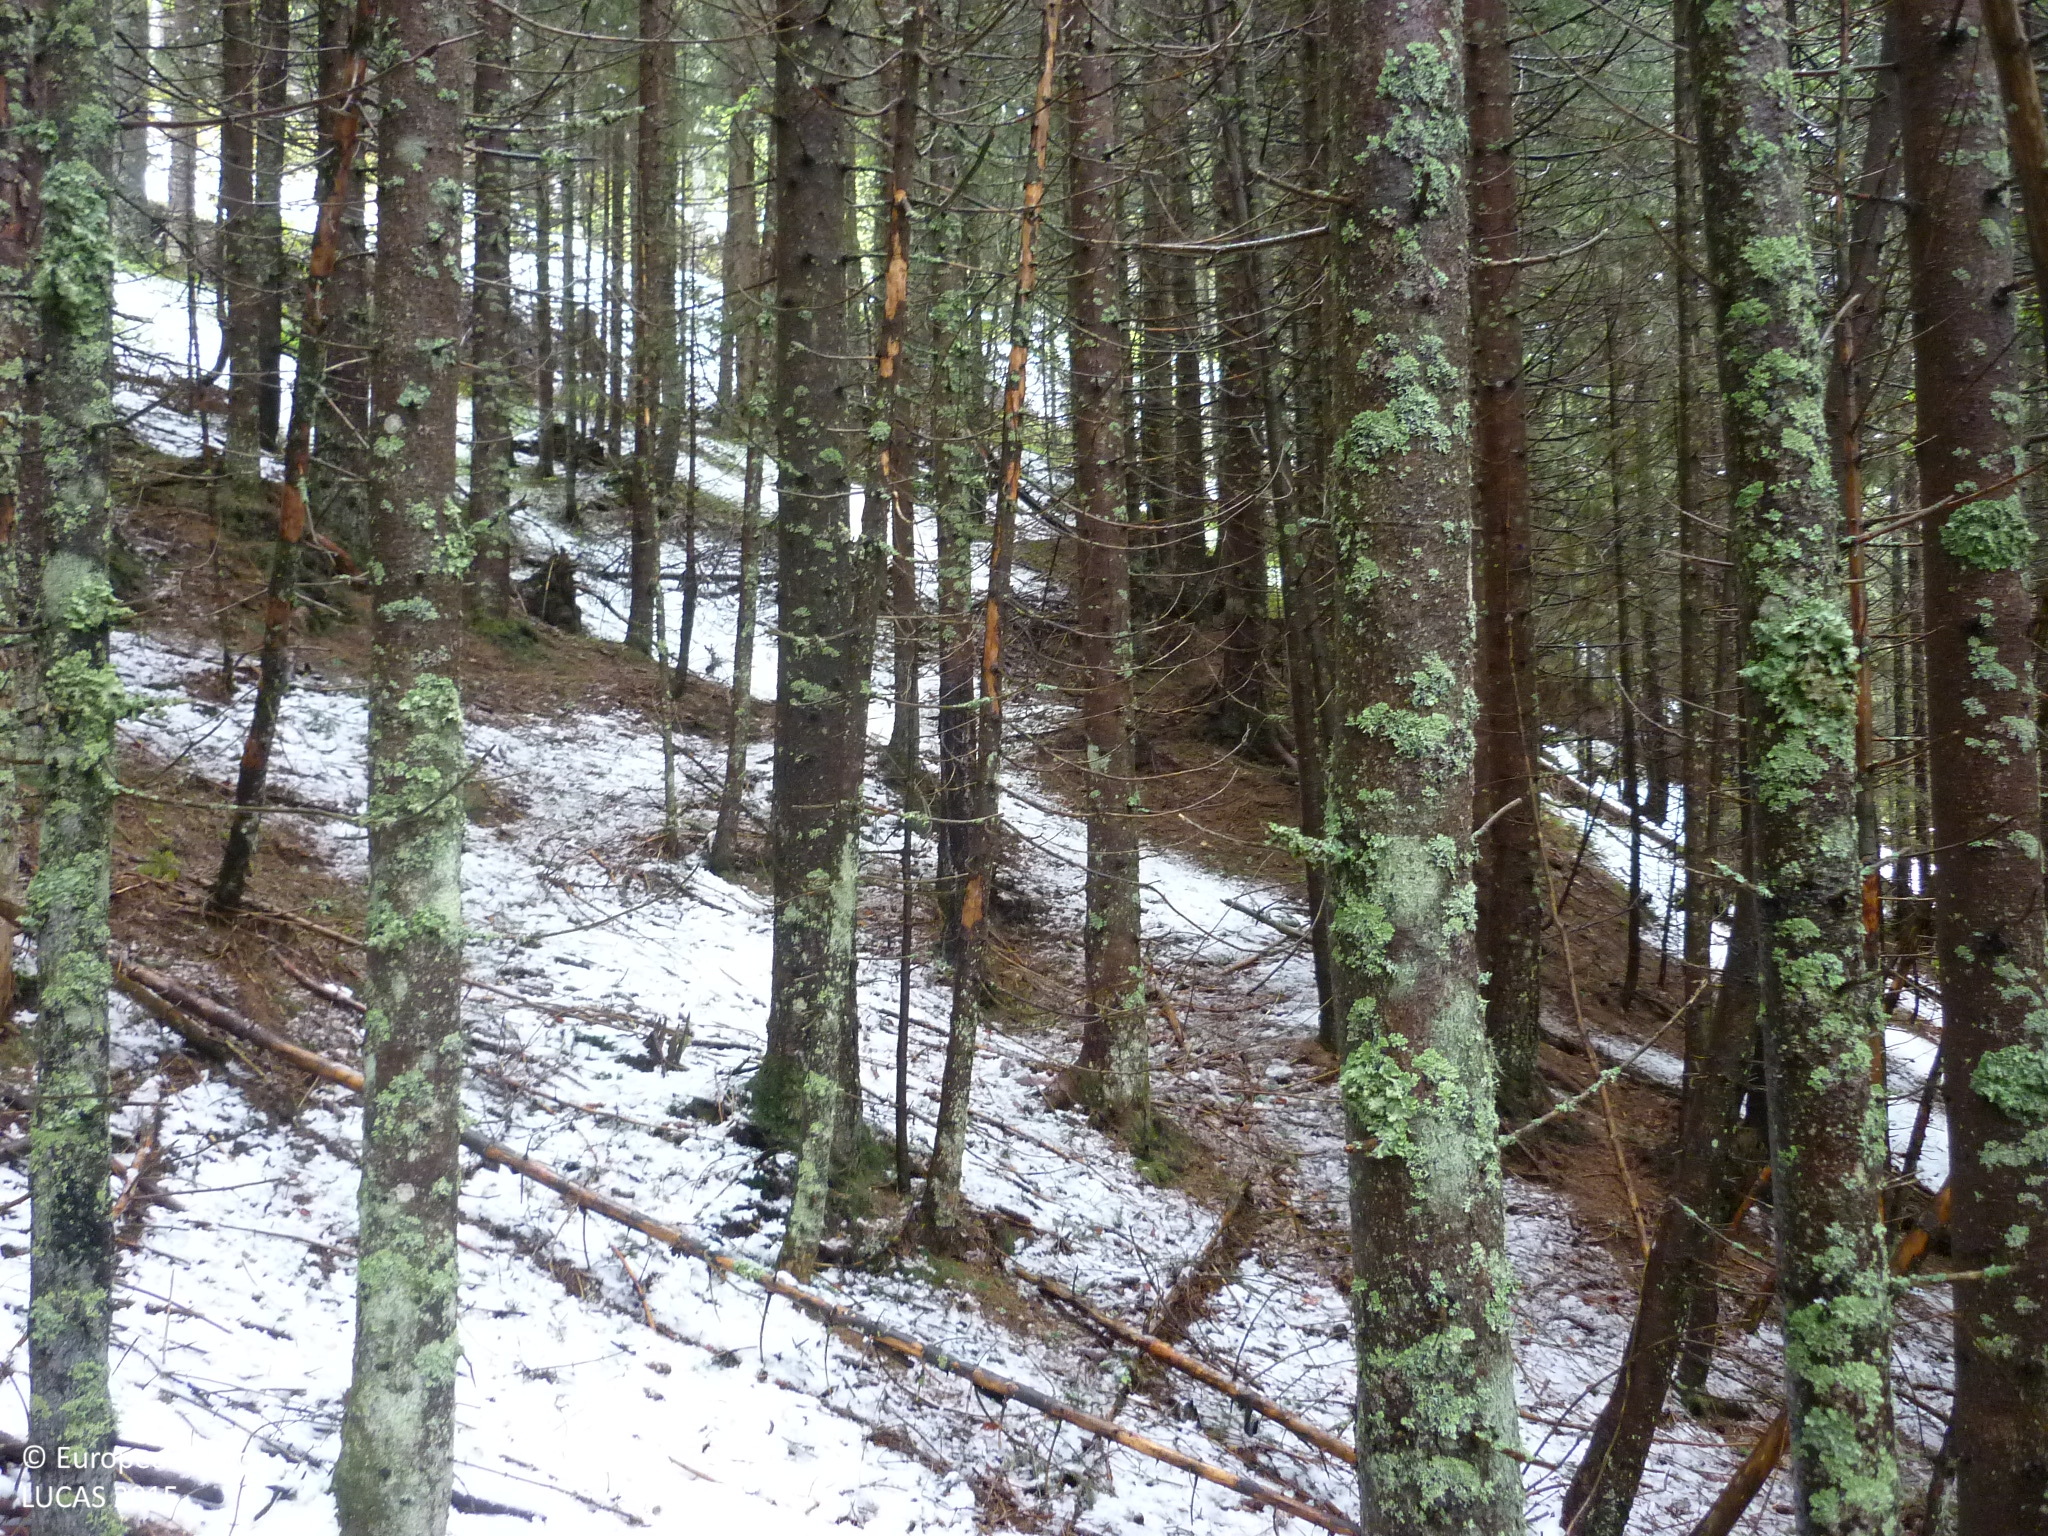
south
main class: Woodland
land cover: Spruce dominated coniferous woodland
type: alpine coniferous forest
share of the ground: > 75 %
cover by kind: coniferous forest trees 95 %, lichens and mosses 5 %
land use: Forestry
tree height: > 5 m
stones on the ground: < 10 %
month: May
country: AT
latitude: 47.4268
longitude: 14.5462
